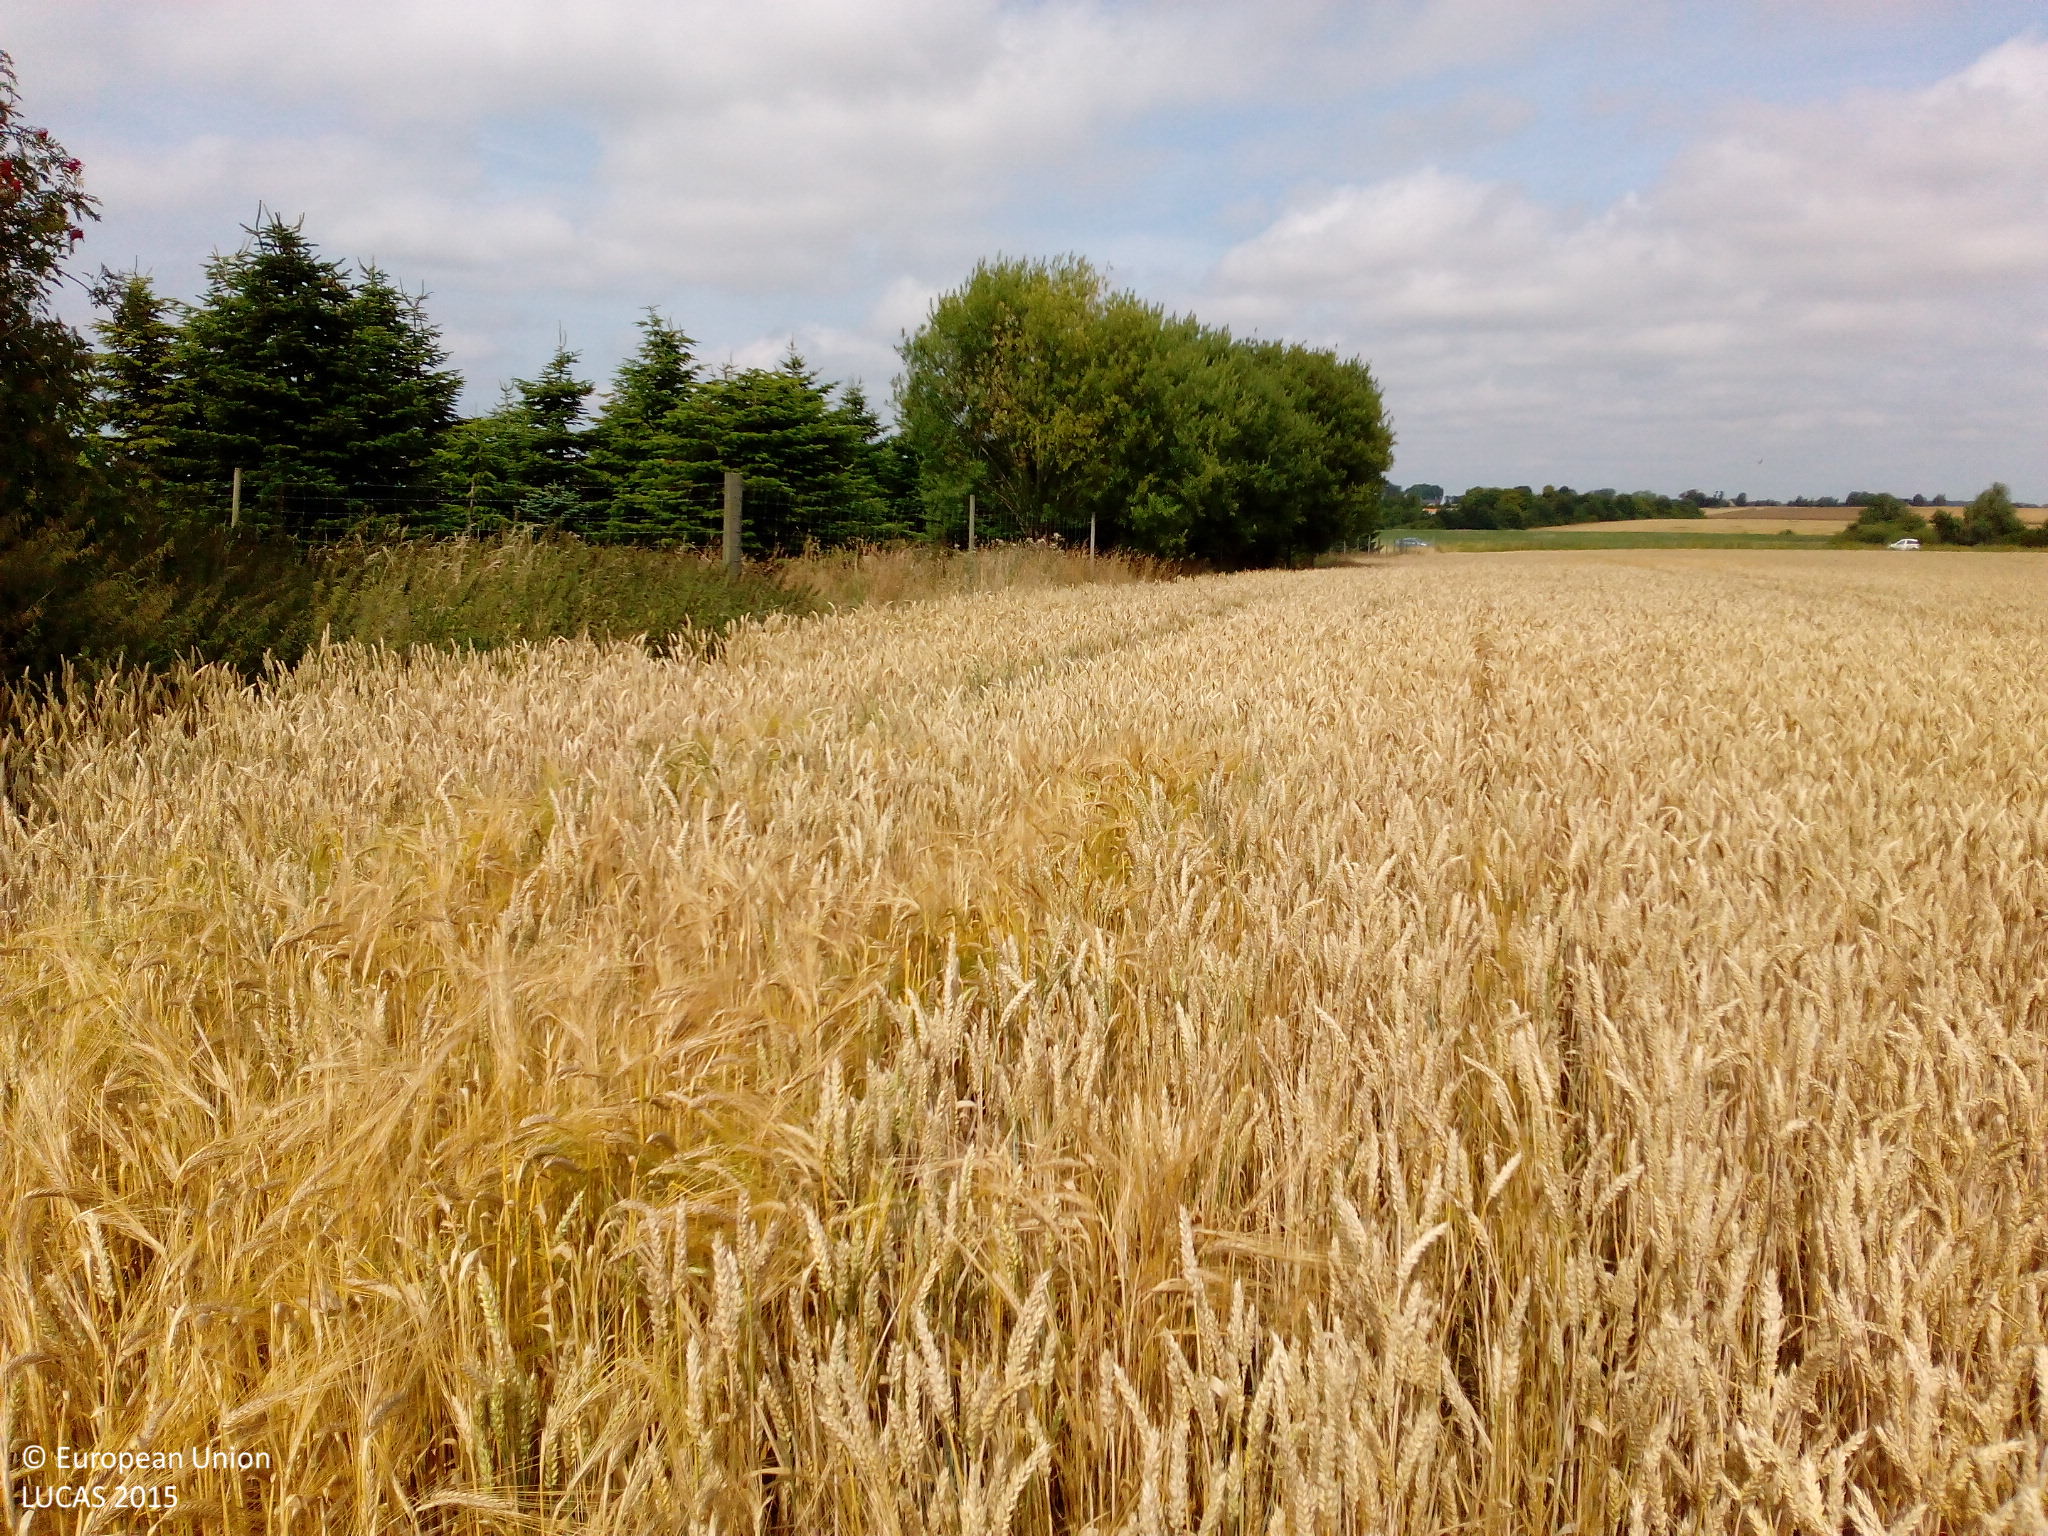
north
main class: Cropland
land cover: Common wheat
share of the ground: > 75 %
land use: Agriculture (excluding fallow land and kitchen gardens)
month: August
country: DK
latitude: 55.5755
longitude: 12.2029
